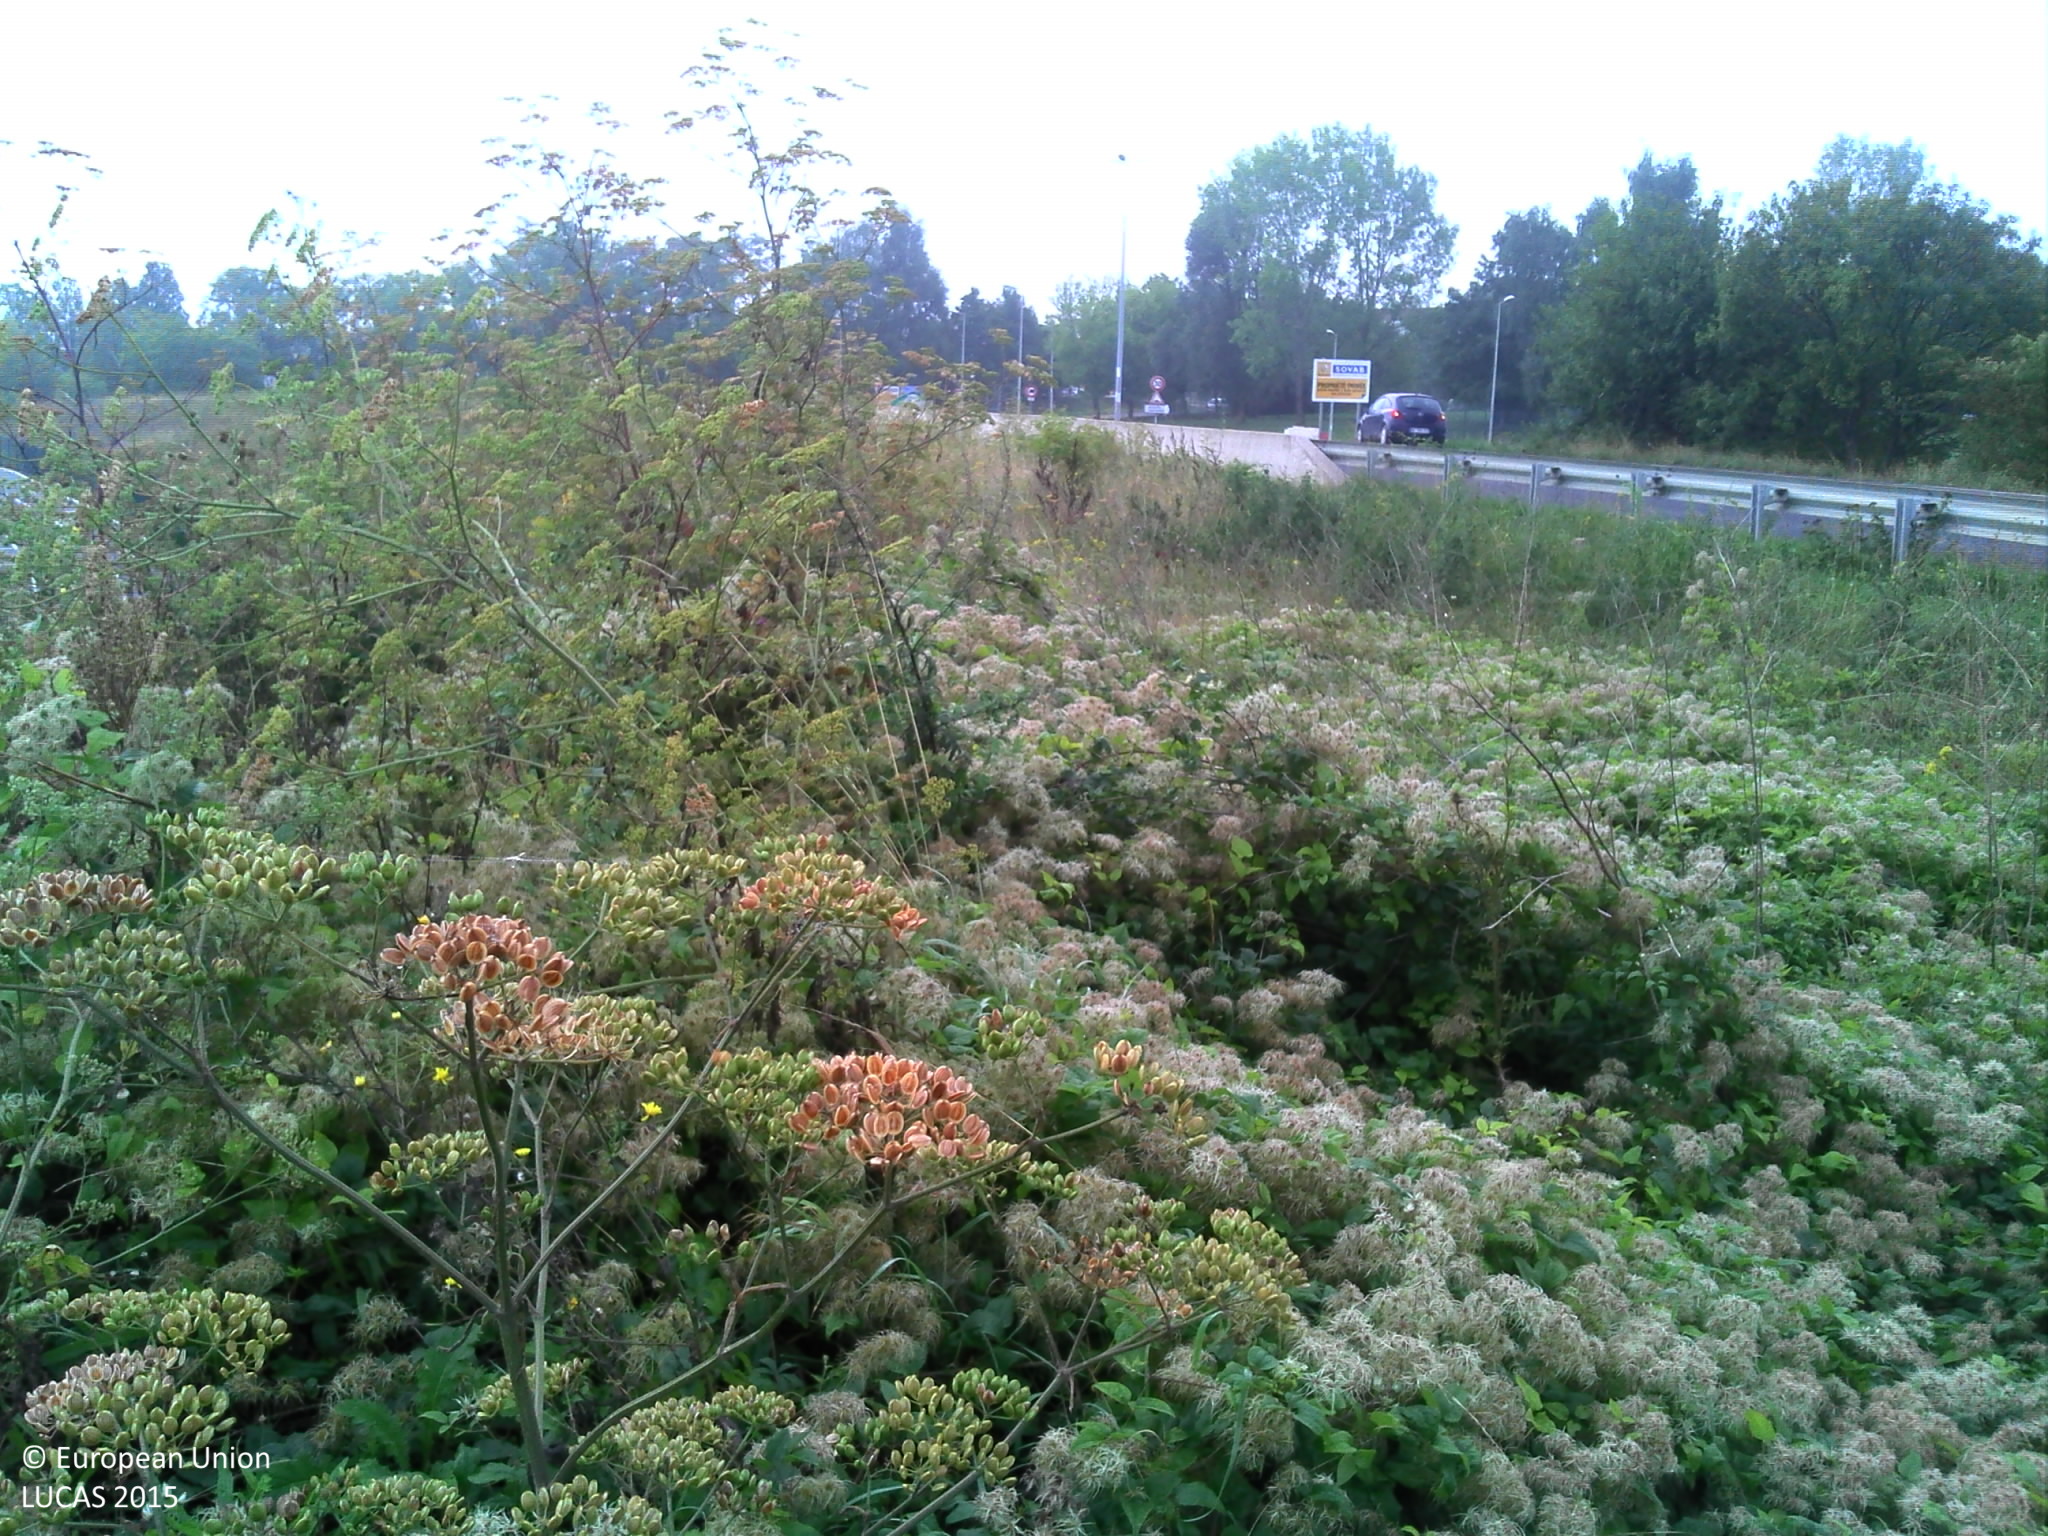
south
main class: Shrubland
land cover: Shrubland without tree cover
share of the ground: 50 - 75 %
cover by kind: shrubs 80 %, herbaceous plants 10 %, consolidated bare surface 5 %, unconsolidated bare surface 5 %
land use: Semi-natural and natural areas not in use
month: September
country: FR
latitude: 49.1770
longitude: 5.9802
